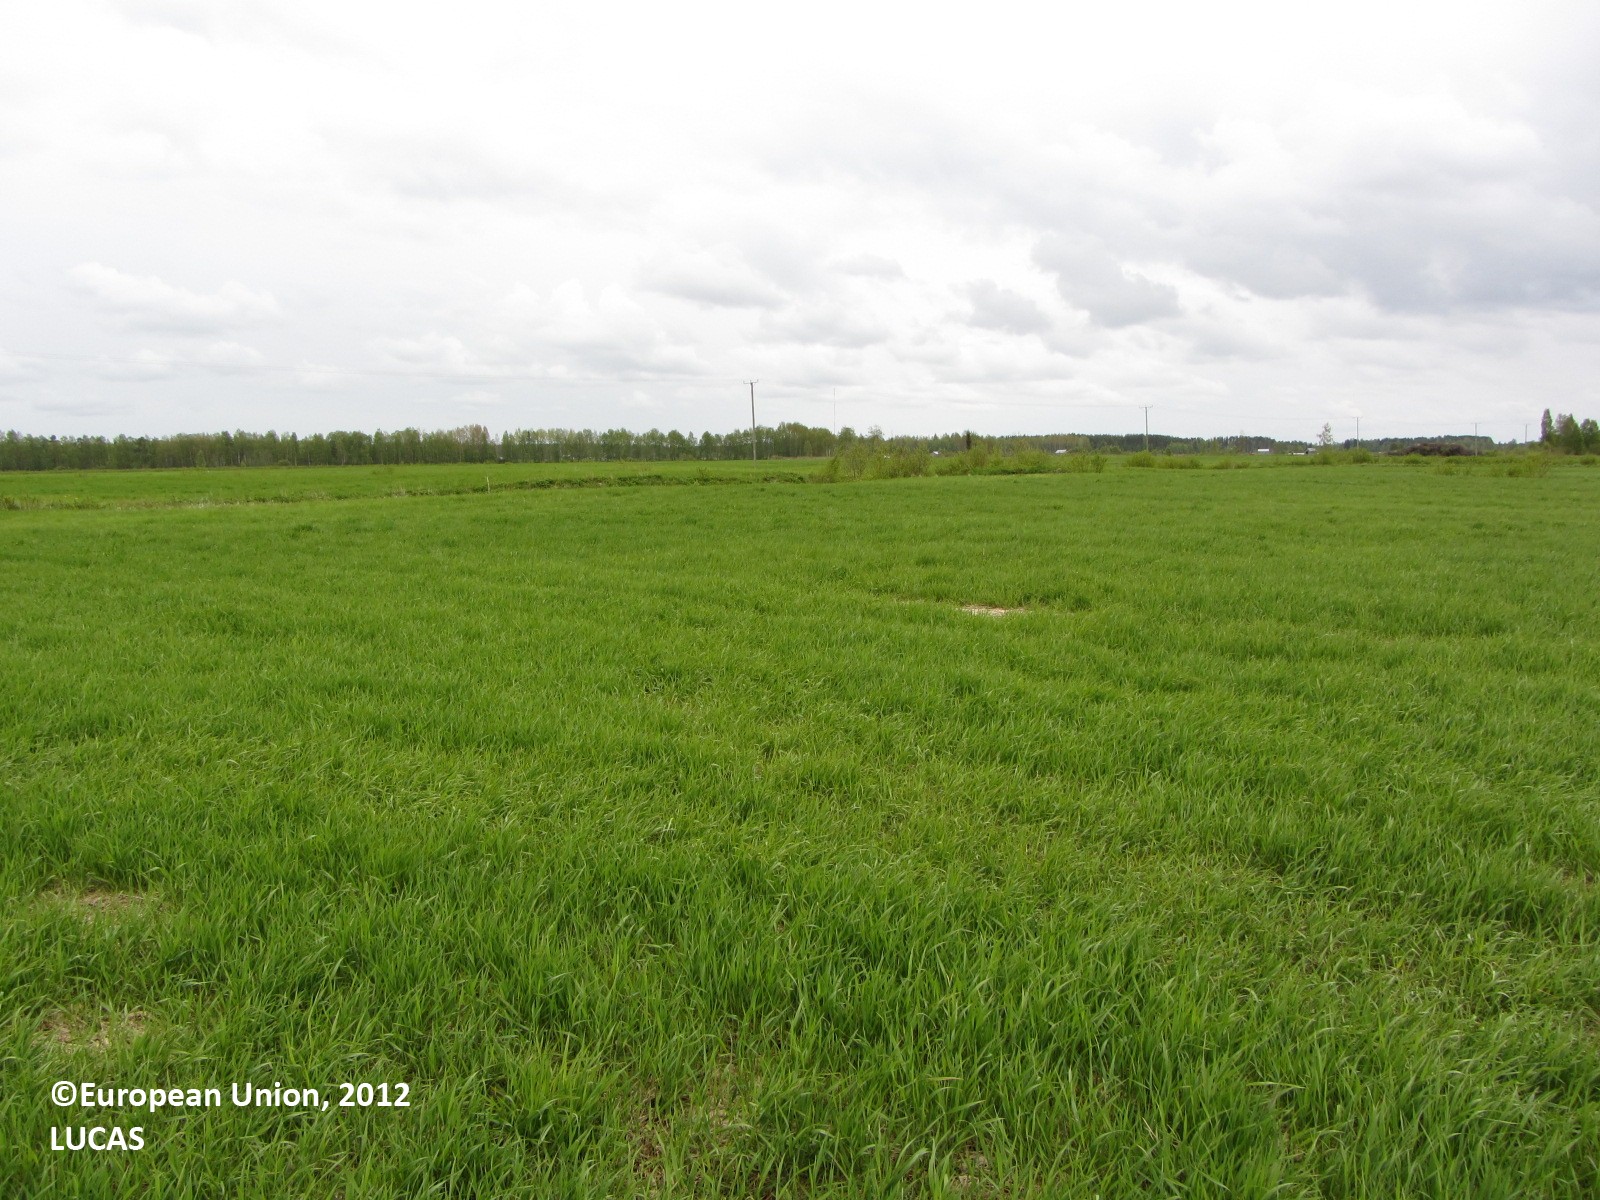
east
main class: Cropland
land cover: Barley
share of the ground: > 75 %
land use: Agriculture (excluding fallow land and kitchen gardens)
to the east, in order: Barley; Abandoned hedges; Ditches and canals; Abandoned hedges; Temporary grasslands; Ditches and canals; Electric lines; Temporary grasslands
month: June
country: FI
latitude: 63.8240
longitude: 24.6476
